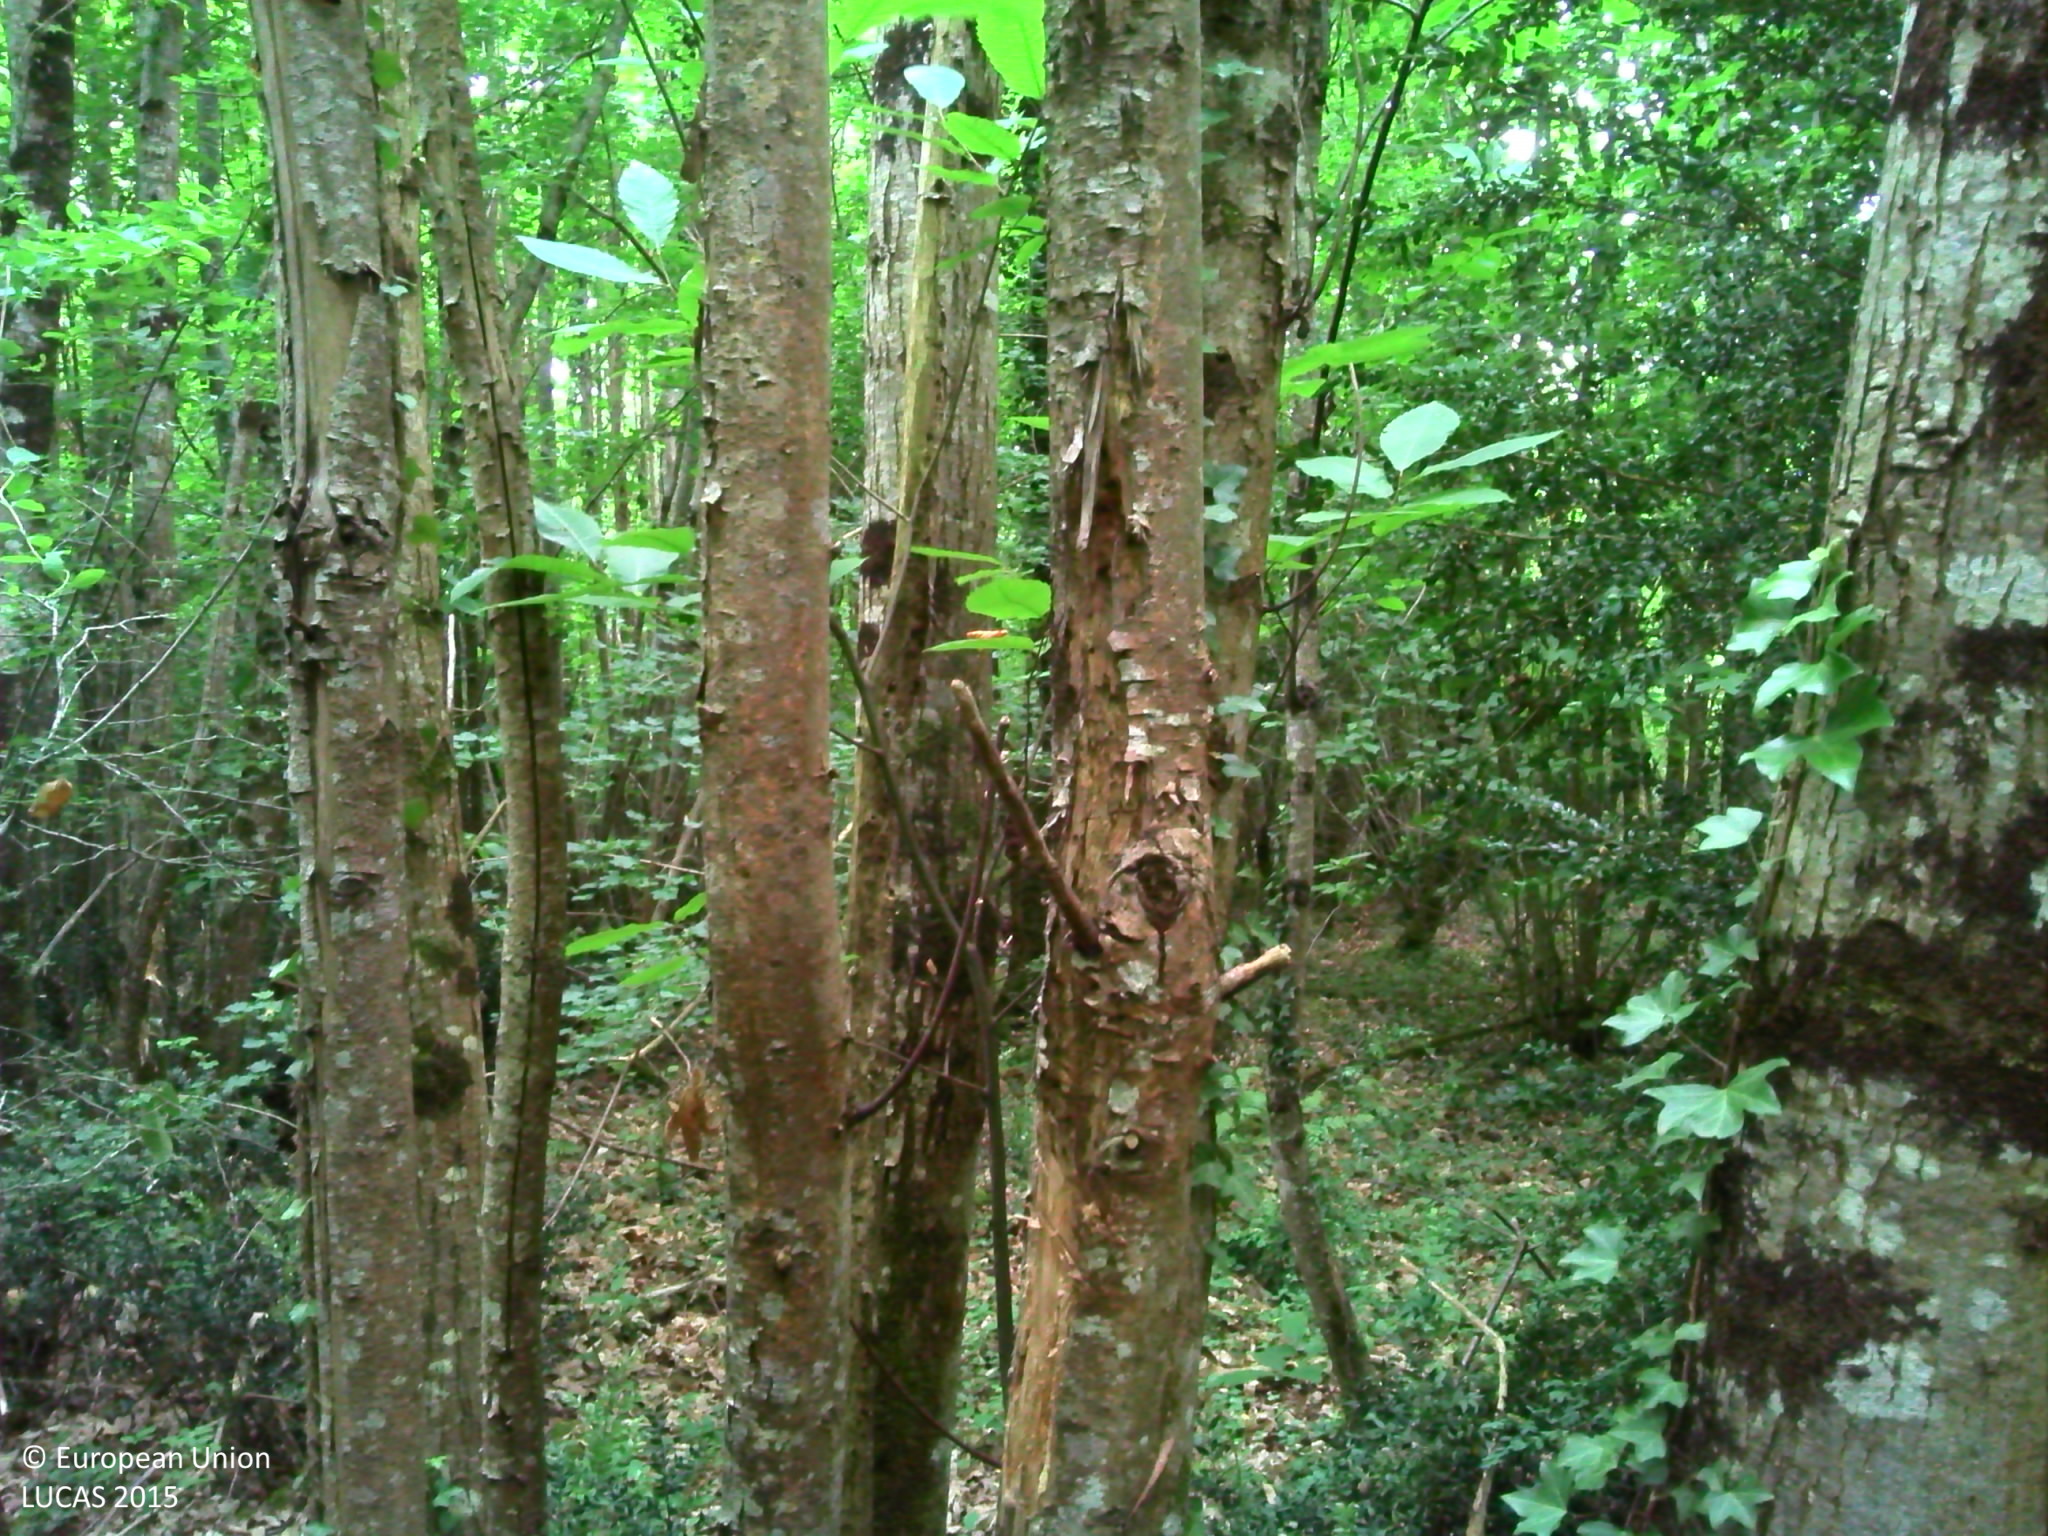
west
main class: Woodland
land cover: Broadleaved woodland
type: thermophilous deciduous forest
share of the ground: > 75 %
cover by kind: broadleaved forest trees 100 %
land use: Forestry
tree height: > 5 m
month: June
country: FR
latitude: 45.9453
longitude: 0.2956
